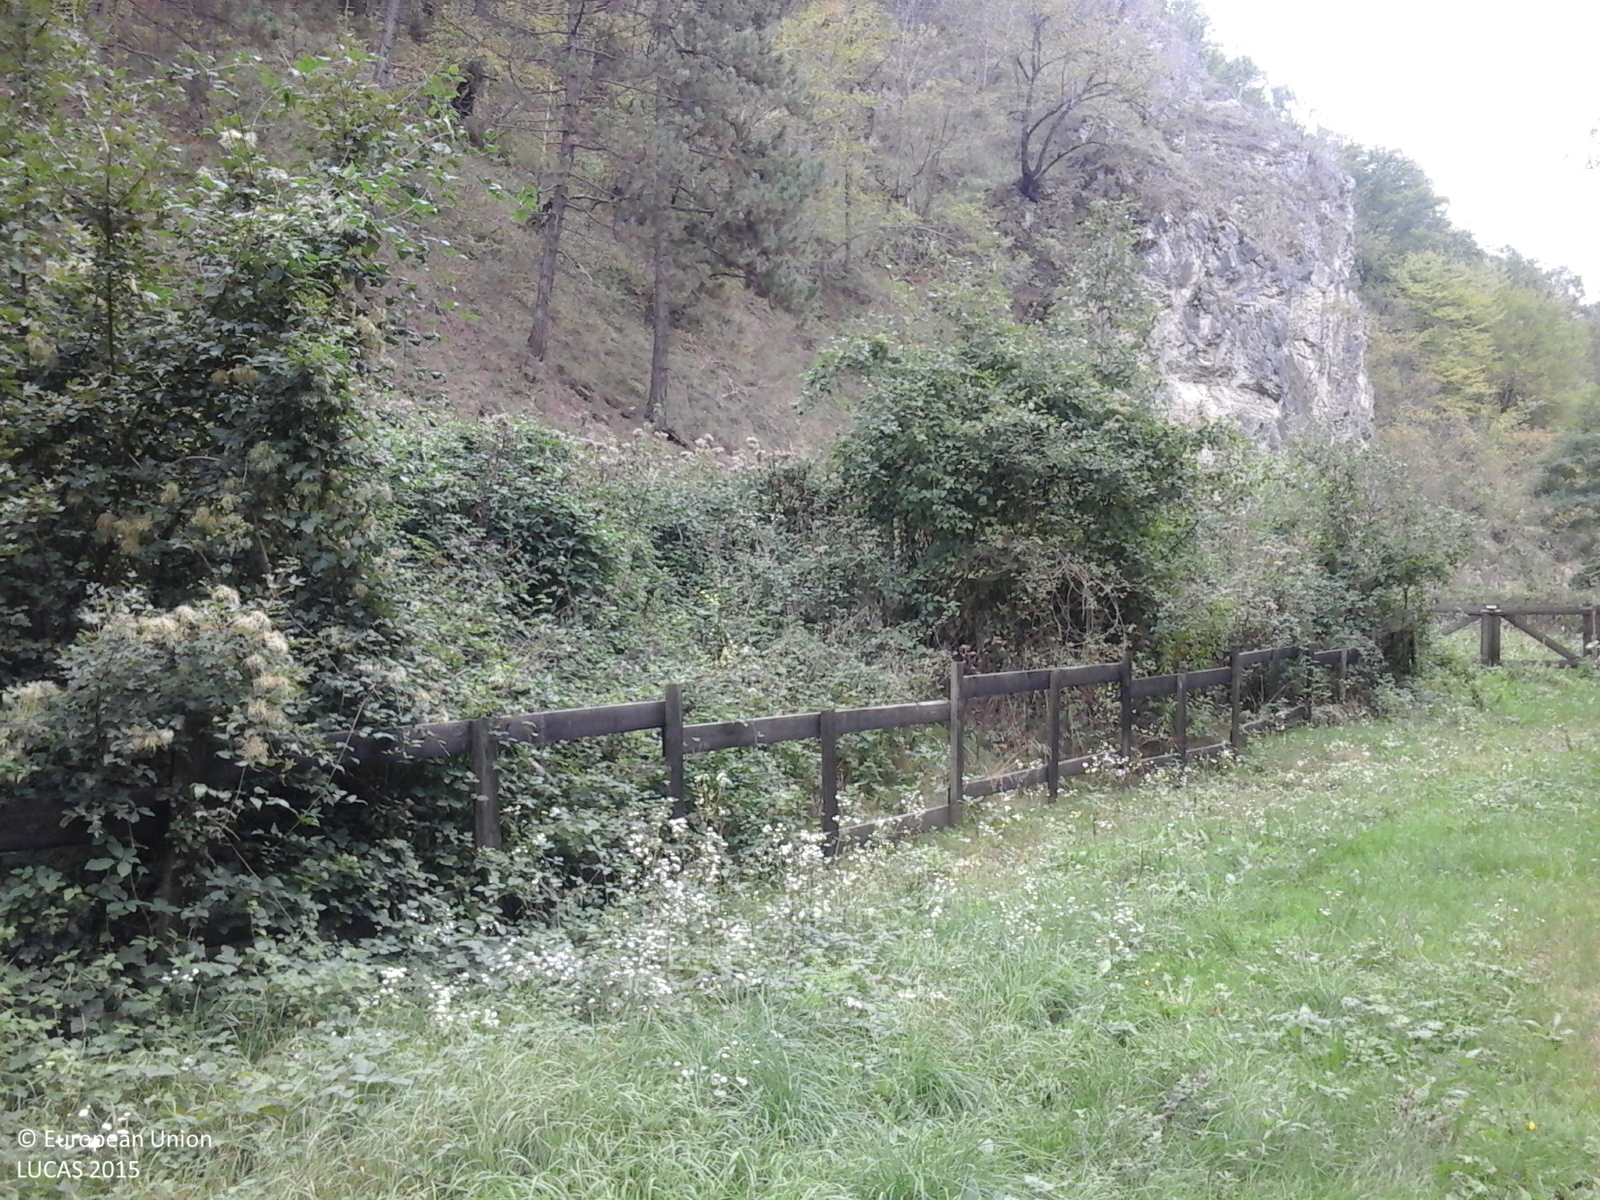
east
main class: Grassland
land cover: Grassland without tree/shrub cover
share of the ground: > 75 %
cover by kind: herbaceous plants 100 %
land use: Residential
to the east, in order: Grassland without tree/shrub cover; Electric lines; Fences; Shruby margins; Tracks; Grass margins; Pine dominated mixed woodland
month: September
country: RO
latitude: 45.7439
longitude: 22.7888
